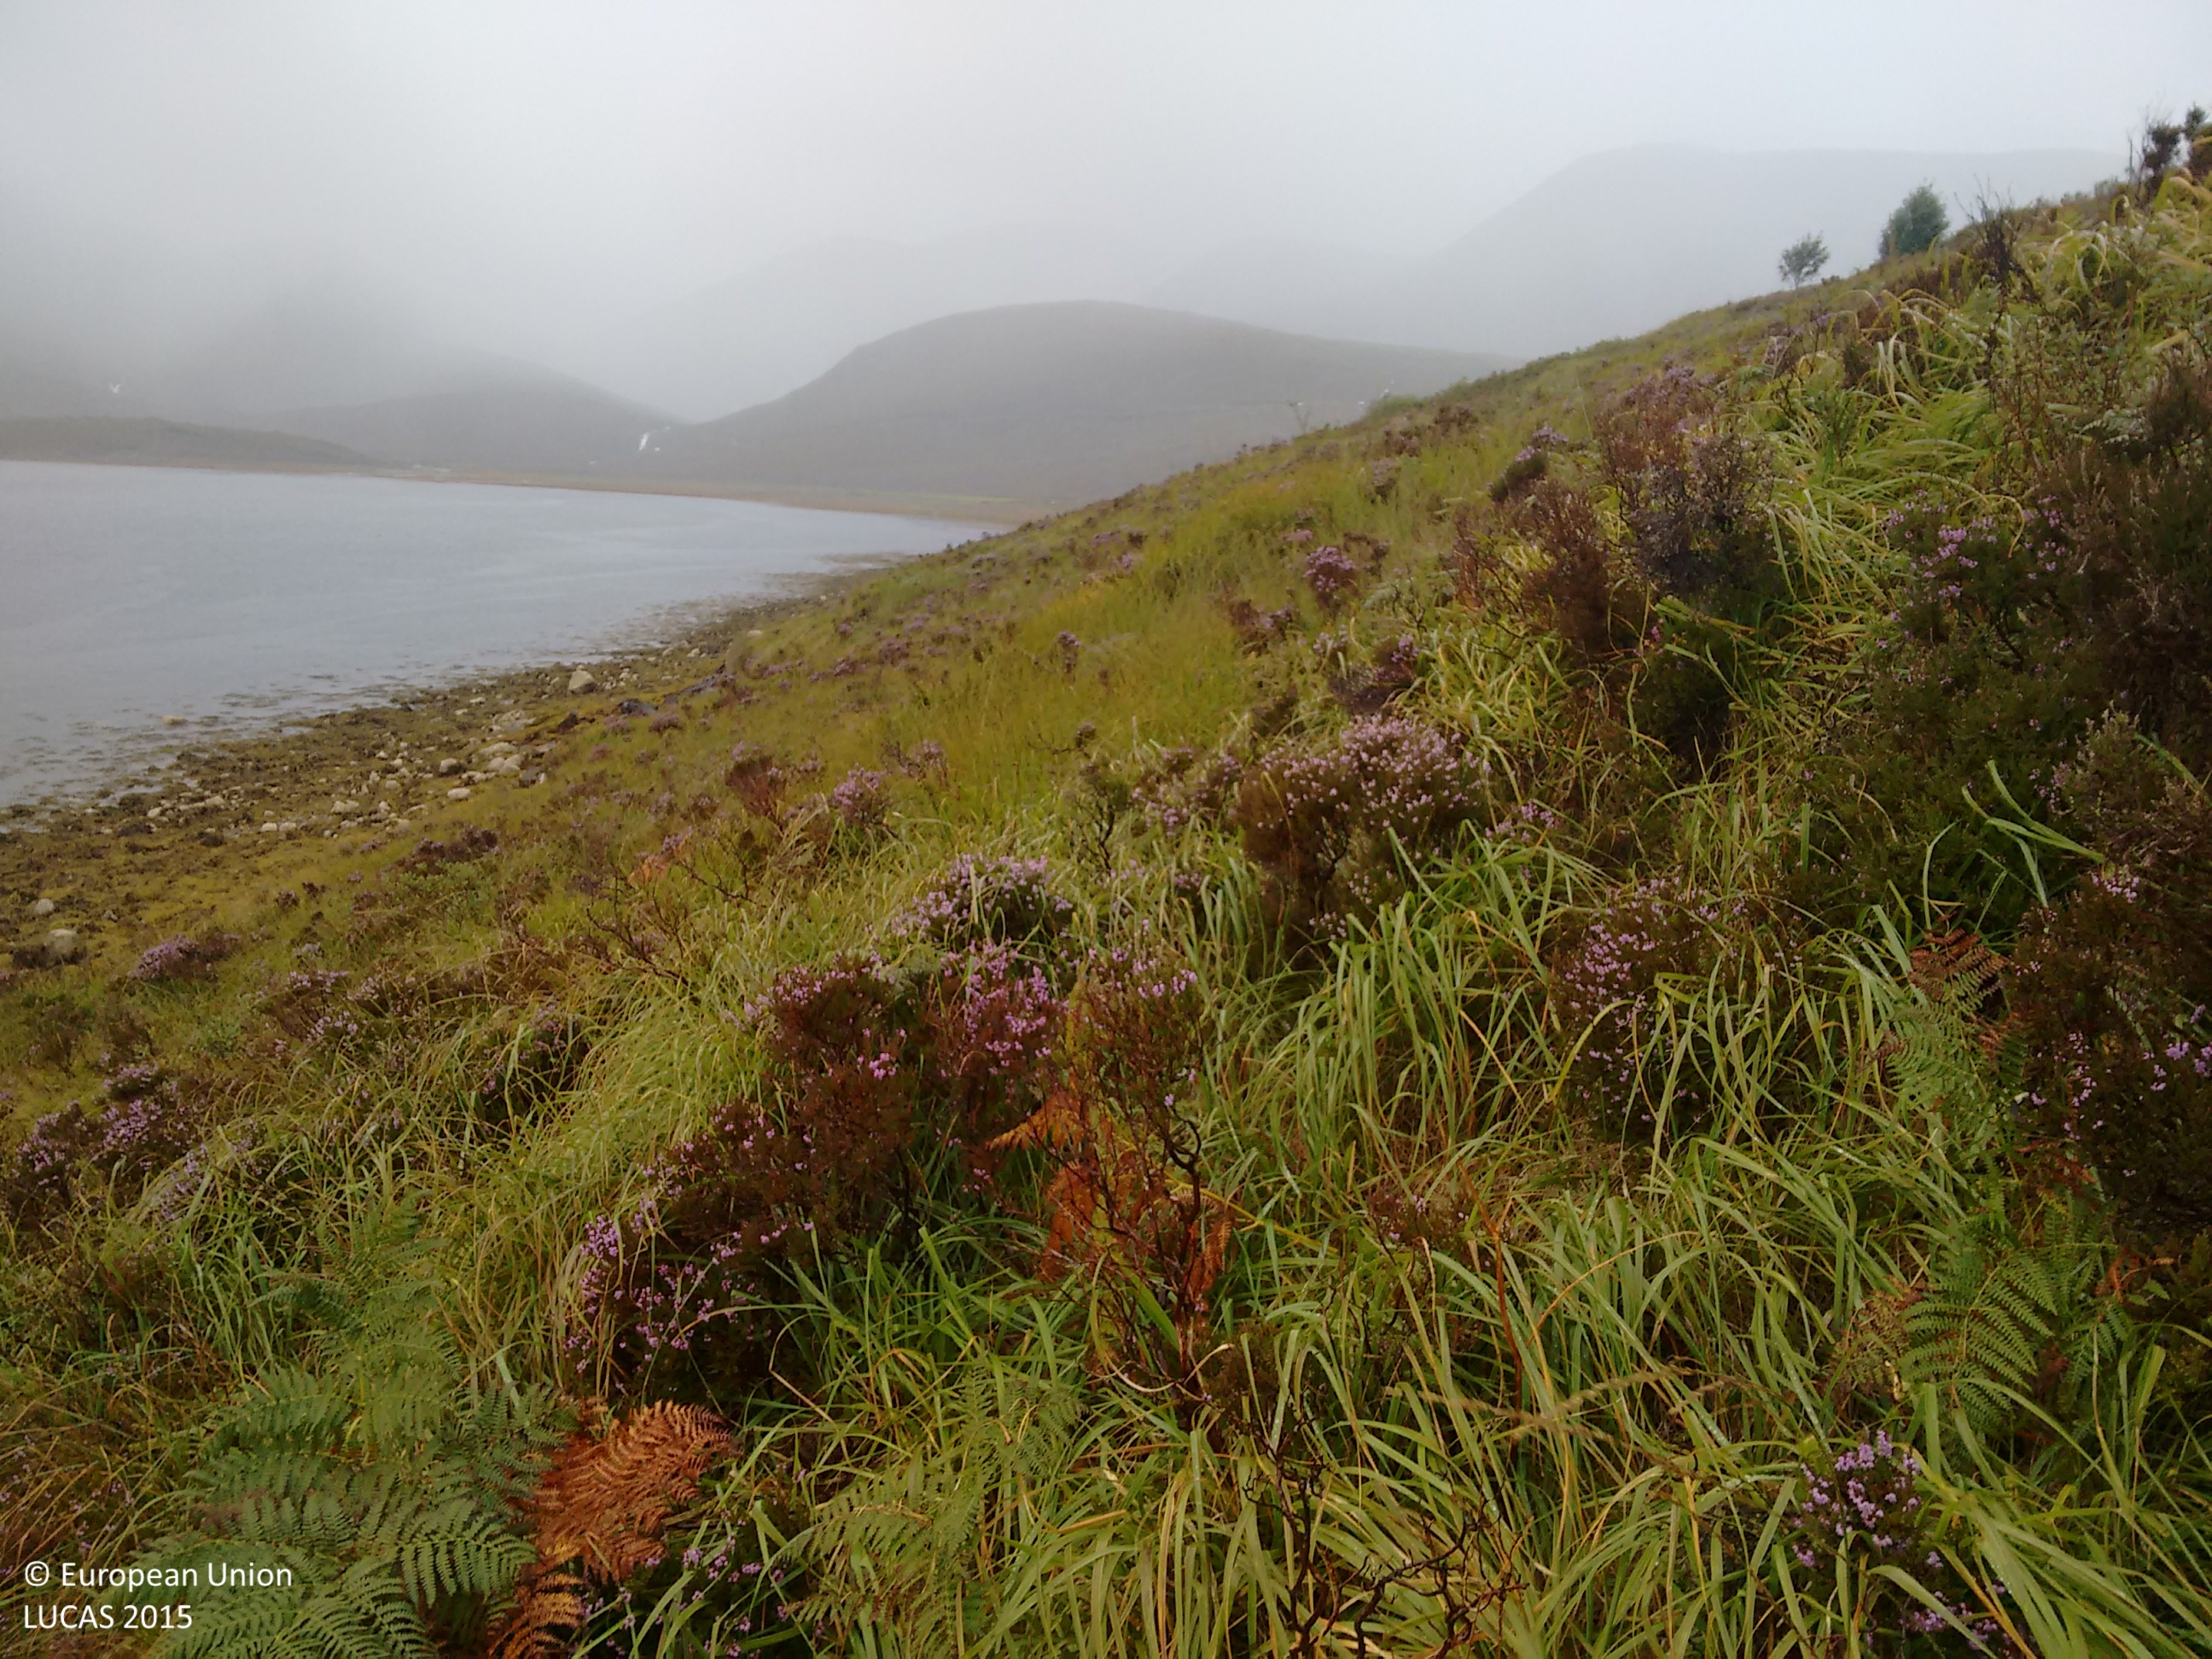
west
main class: Shrubland
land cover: Shrubland without tree cover
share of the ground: 50 - 75 %
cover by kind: shrubs 60 %, herbaceous plants 40 %
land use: Semi-natural and natural areas not in use
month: September
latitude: 57.2792
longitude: -6.0718
